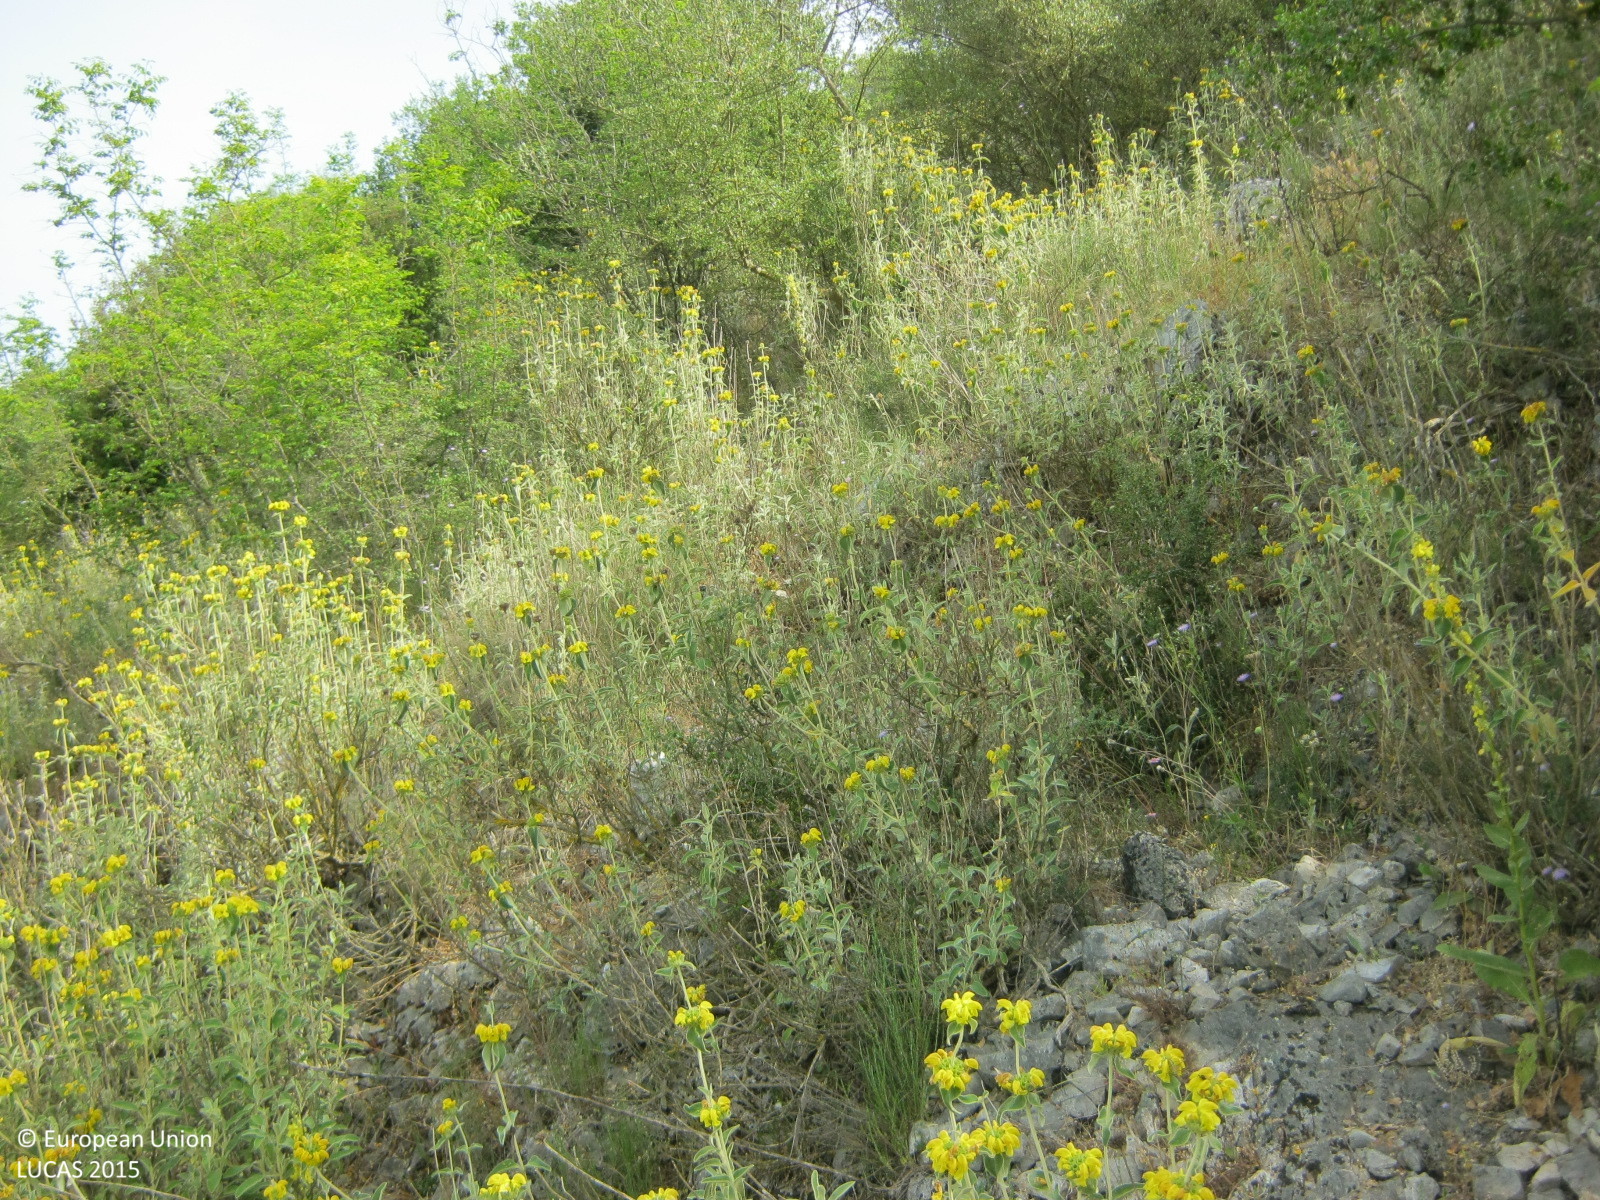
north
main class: Shrubland
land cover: Shrubland without tree cover
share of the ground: 50 - 75 %
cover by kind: shrubs 50 %, herbaceous plants 40 %, consolidated bare surface 10 %
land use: Agriculture (excluding fallow land and kitchen gardens)
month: May
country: GR
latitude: 39.3127
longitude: 20.8885
